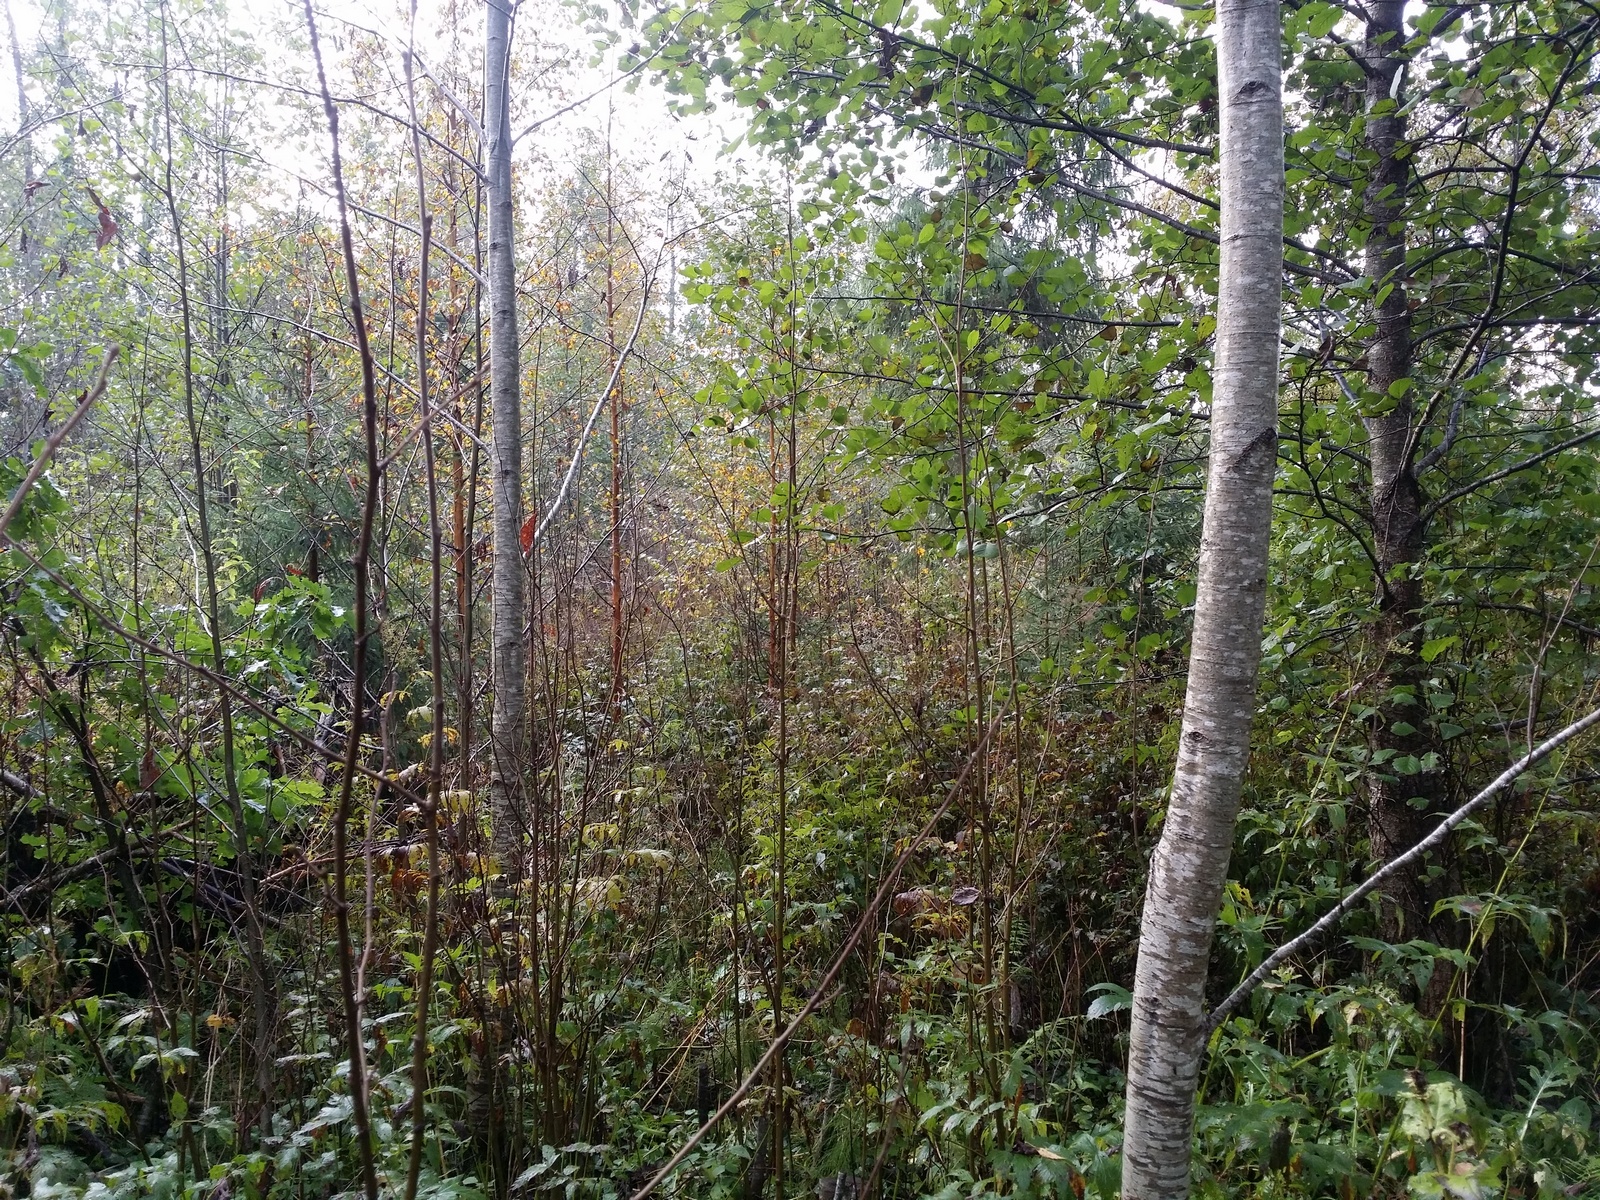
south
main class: Woodland
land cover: Broadleaved woodland
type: non-riverine alder, birch or aspen forest
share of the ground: 50 - 75 %
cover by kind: broadleaved forest trees 70 %, shrubs 15 %, herbaceous plants 10 %, coniferous forest trees 5 %
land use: Forestry
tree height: > 5 m
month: September
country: LV
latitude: 57.3381
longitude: 27.3313
